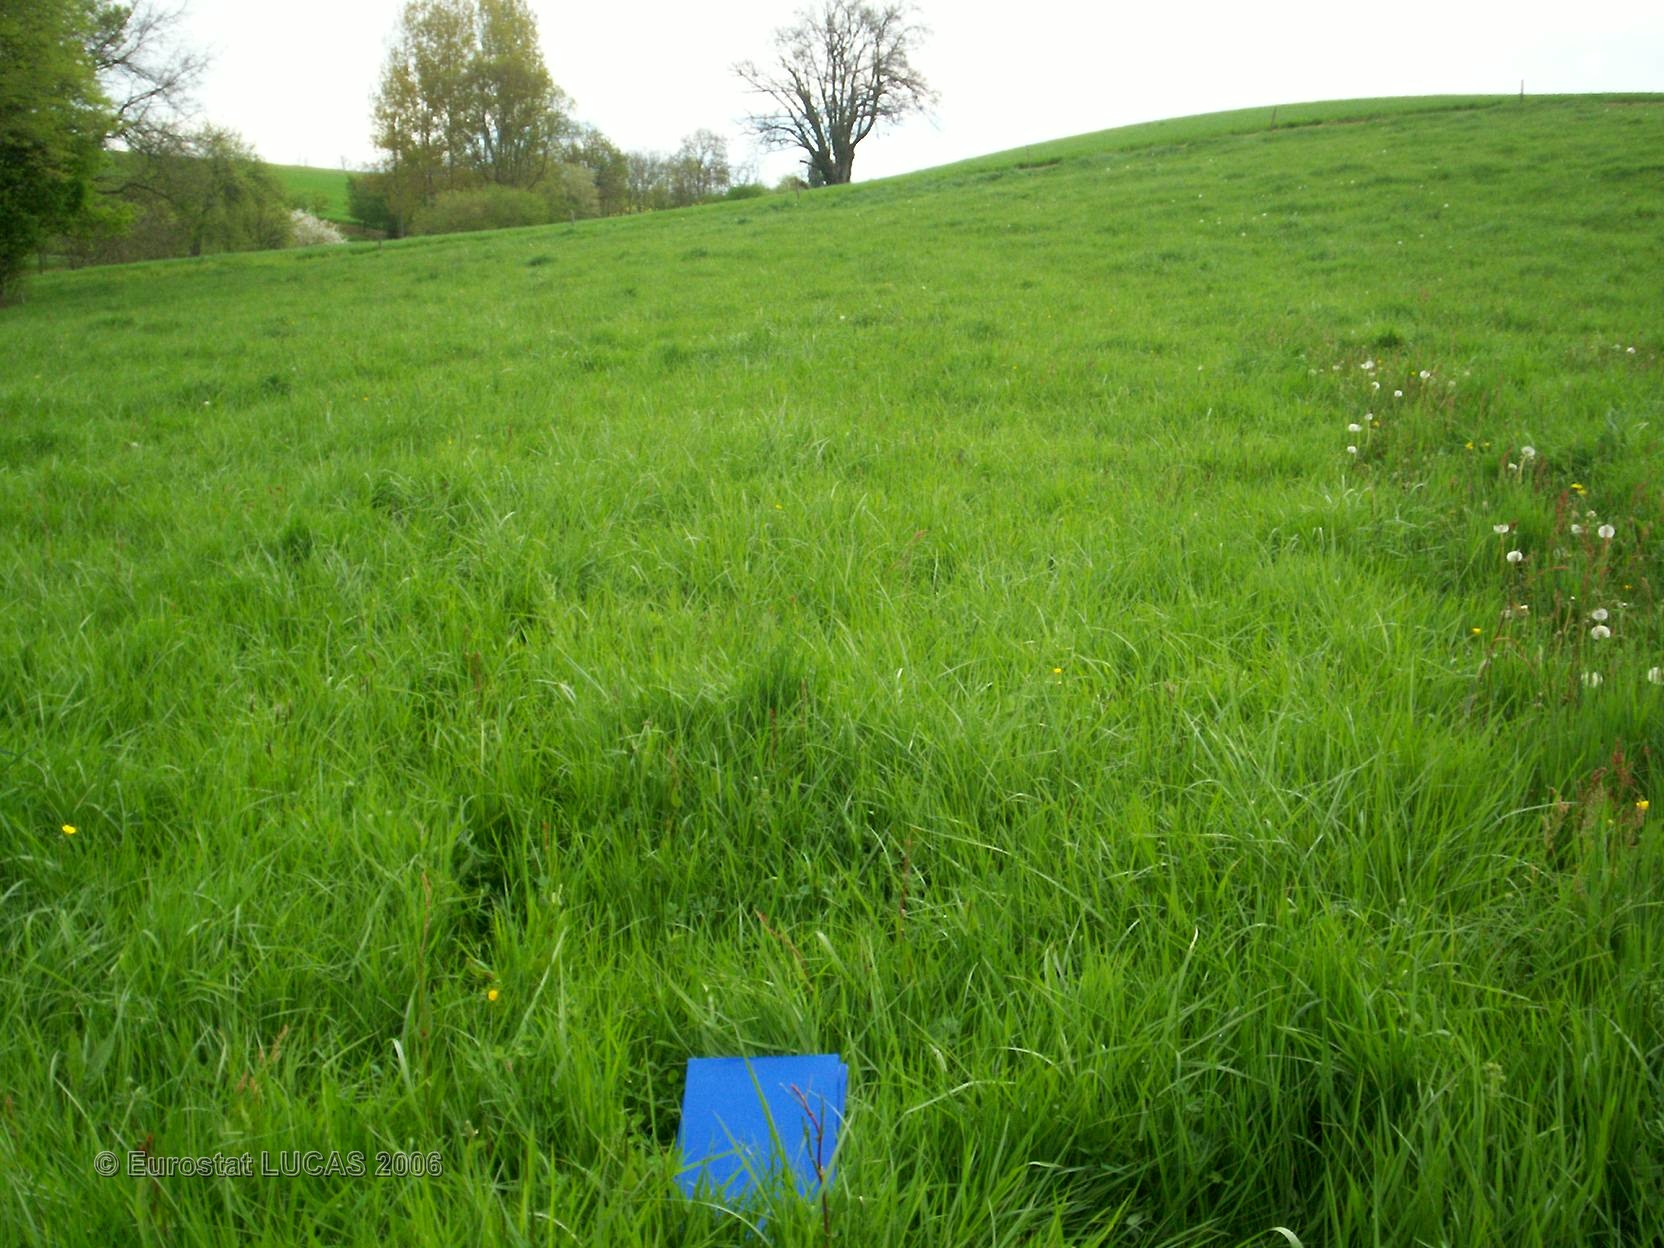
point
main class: Grassland
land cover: Grassland without tree/shrub cover
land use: Agriculture (excluding fallow land and kitchen gardens)
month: April
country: FR
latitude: 43.7223
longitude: 0.2007
